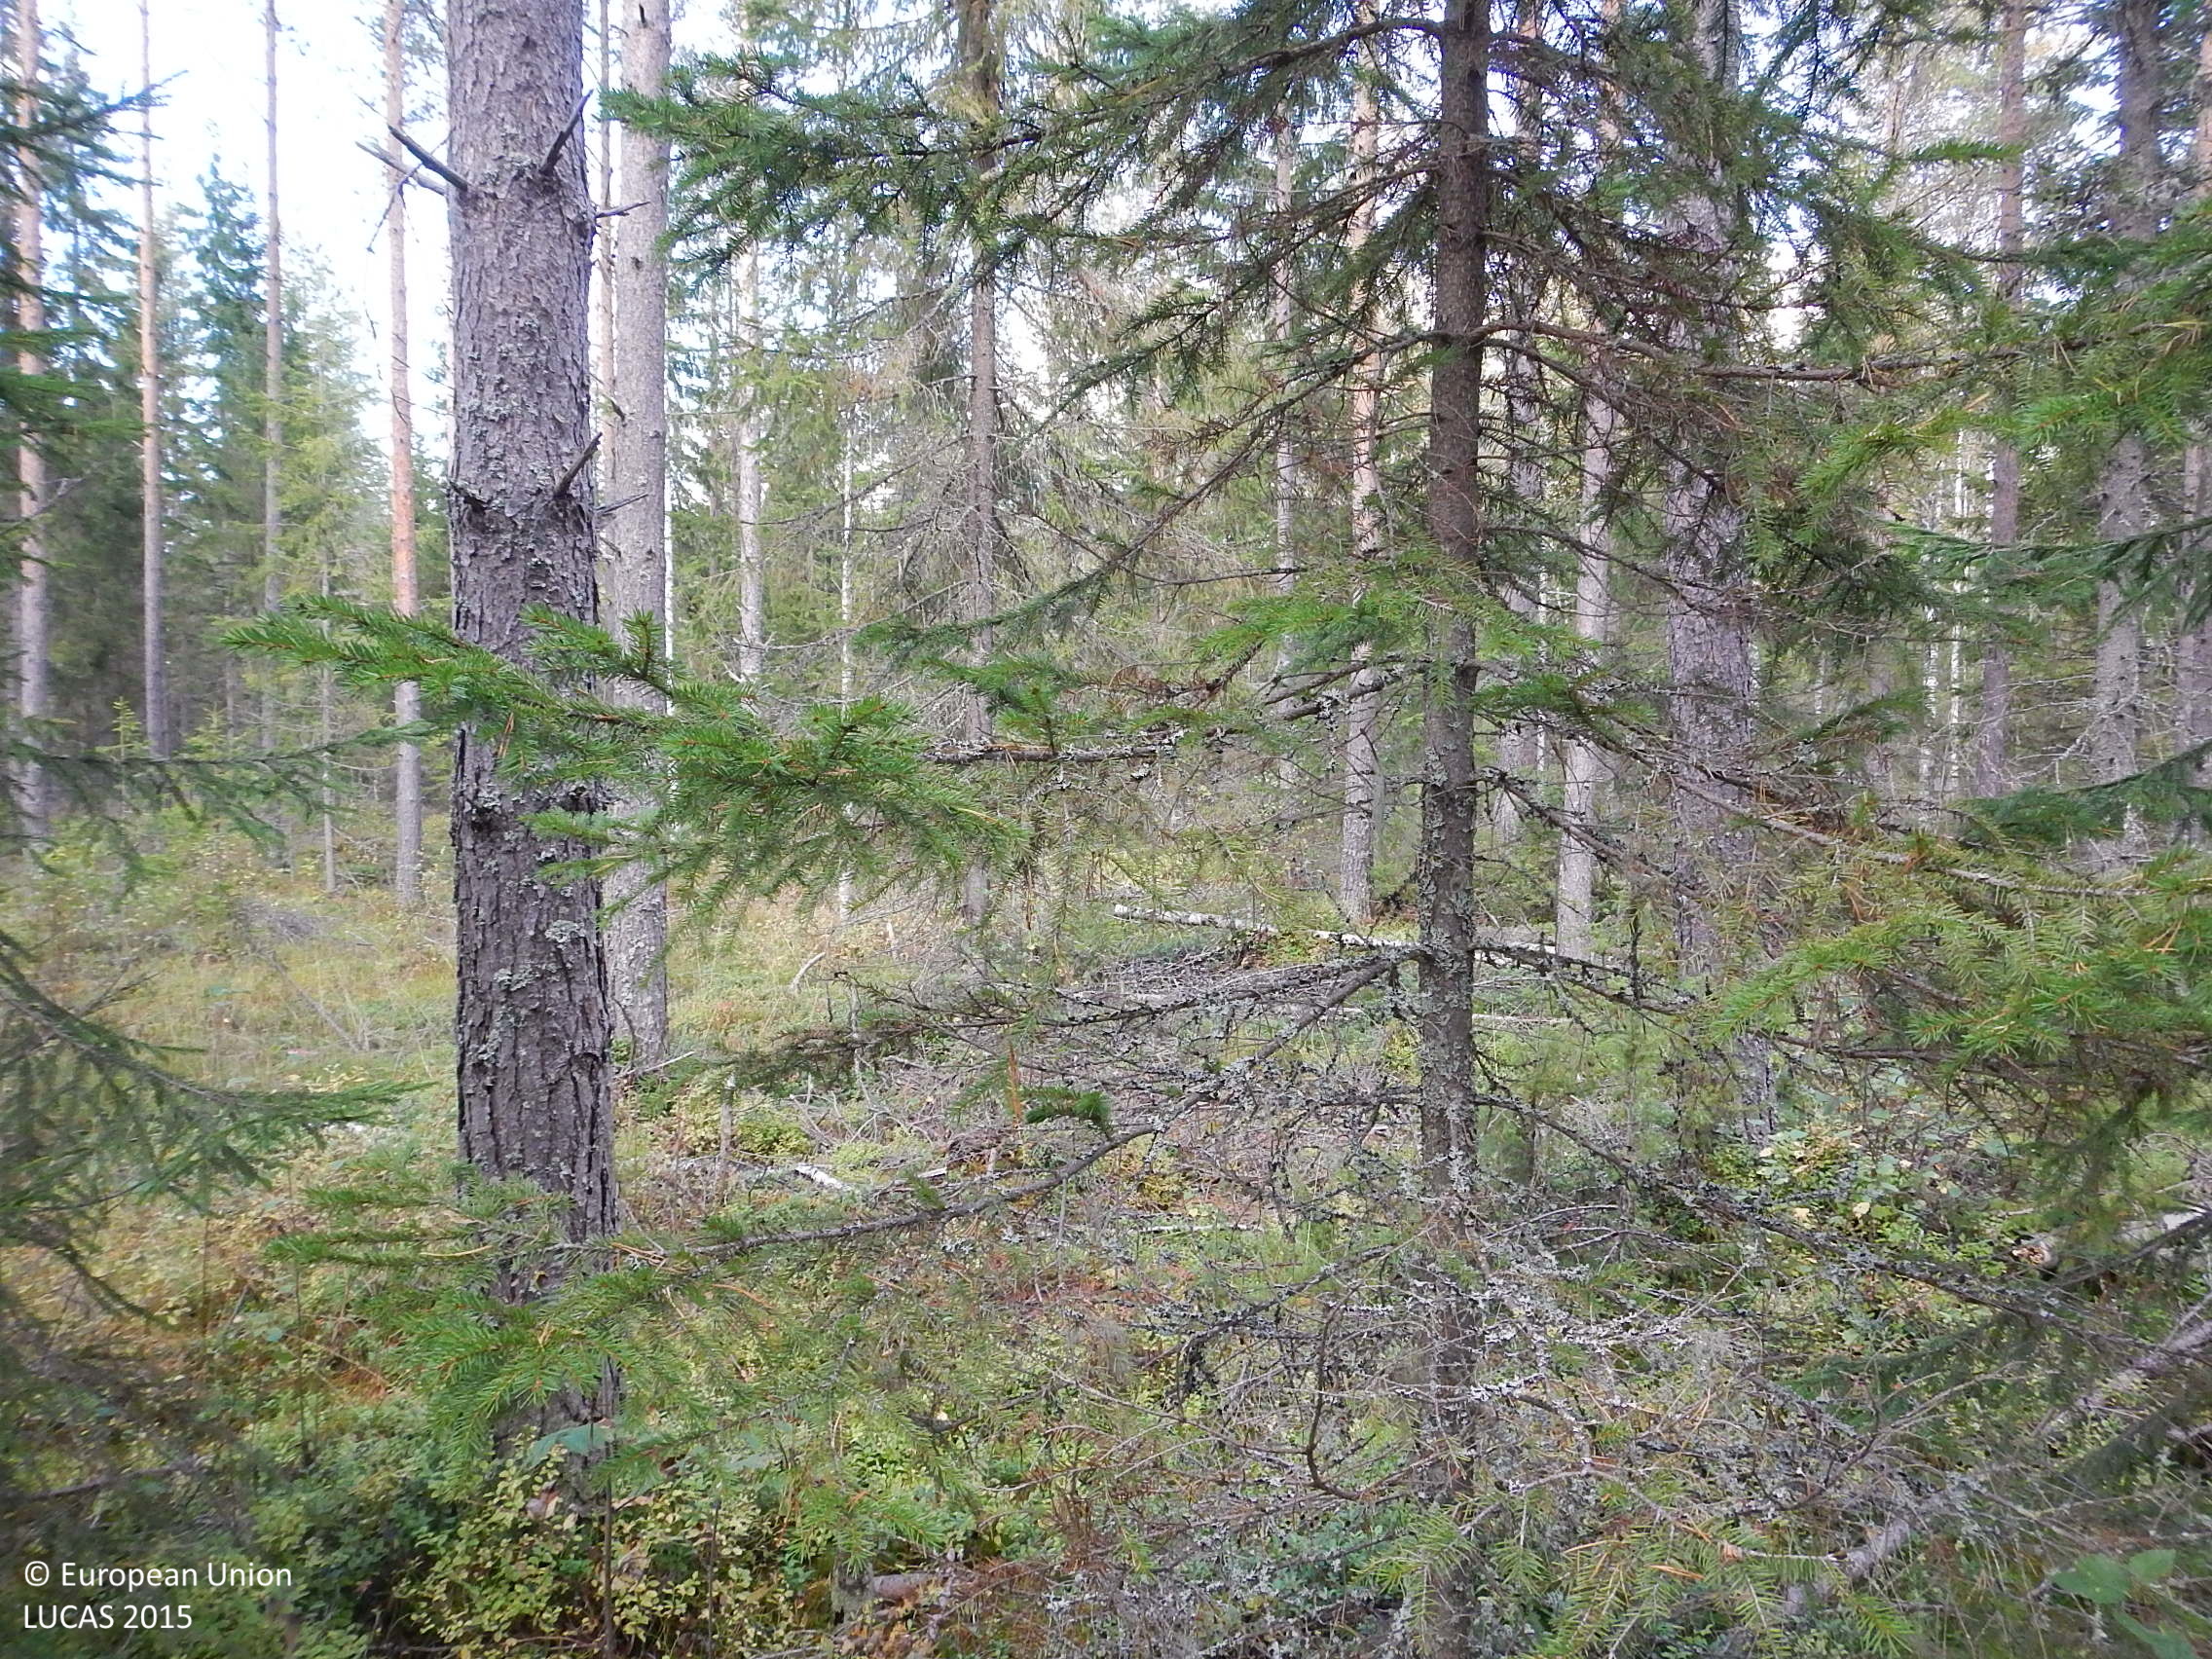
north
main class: Woodland
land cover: Other mixed woodland
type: boreal forest
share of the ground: > 75 %
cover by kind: coniferous forest trees 55 %, broadleaved forest trees 25 %, shrubs 20 %
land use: Forestry
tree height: > 5 m
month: September
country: FI
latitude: 61.9551
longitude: 22.7810
